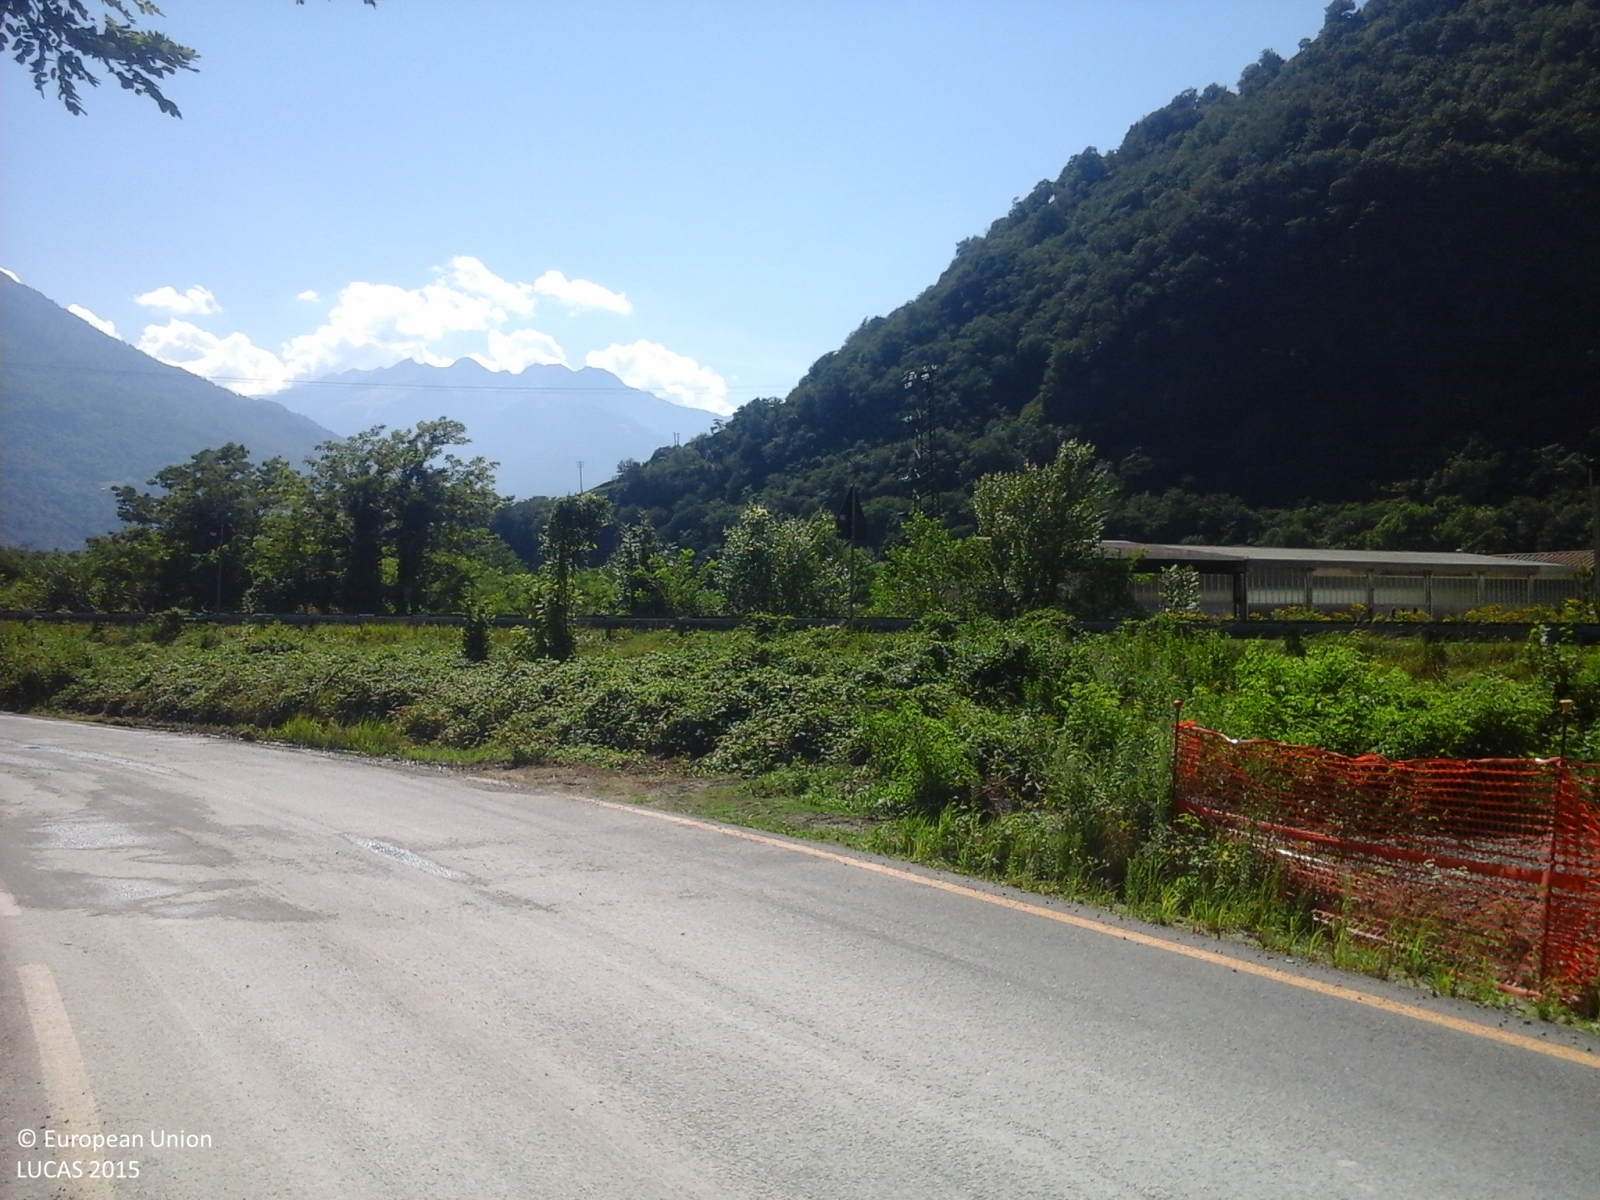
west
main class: Woodland
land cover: Broadleaved woodland
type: thermophilous deciduous forest
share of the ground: > 75 %
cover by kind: broadleaved forest trees 100 %
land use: Forestry
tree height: > 5 m
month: August
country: IT
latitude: 46.1524
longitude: 9.6250
